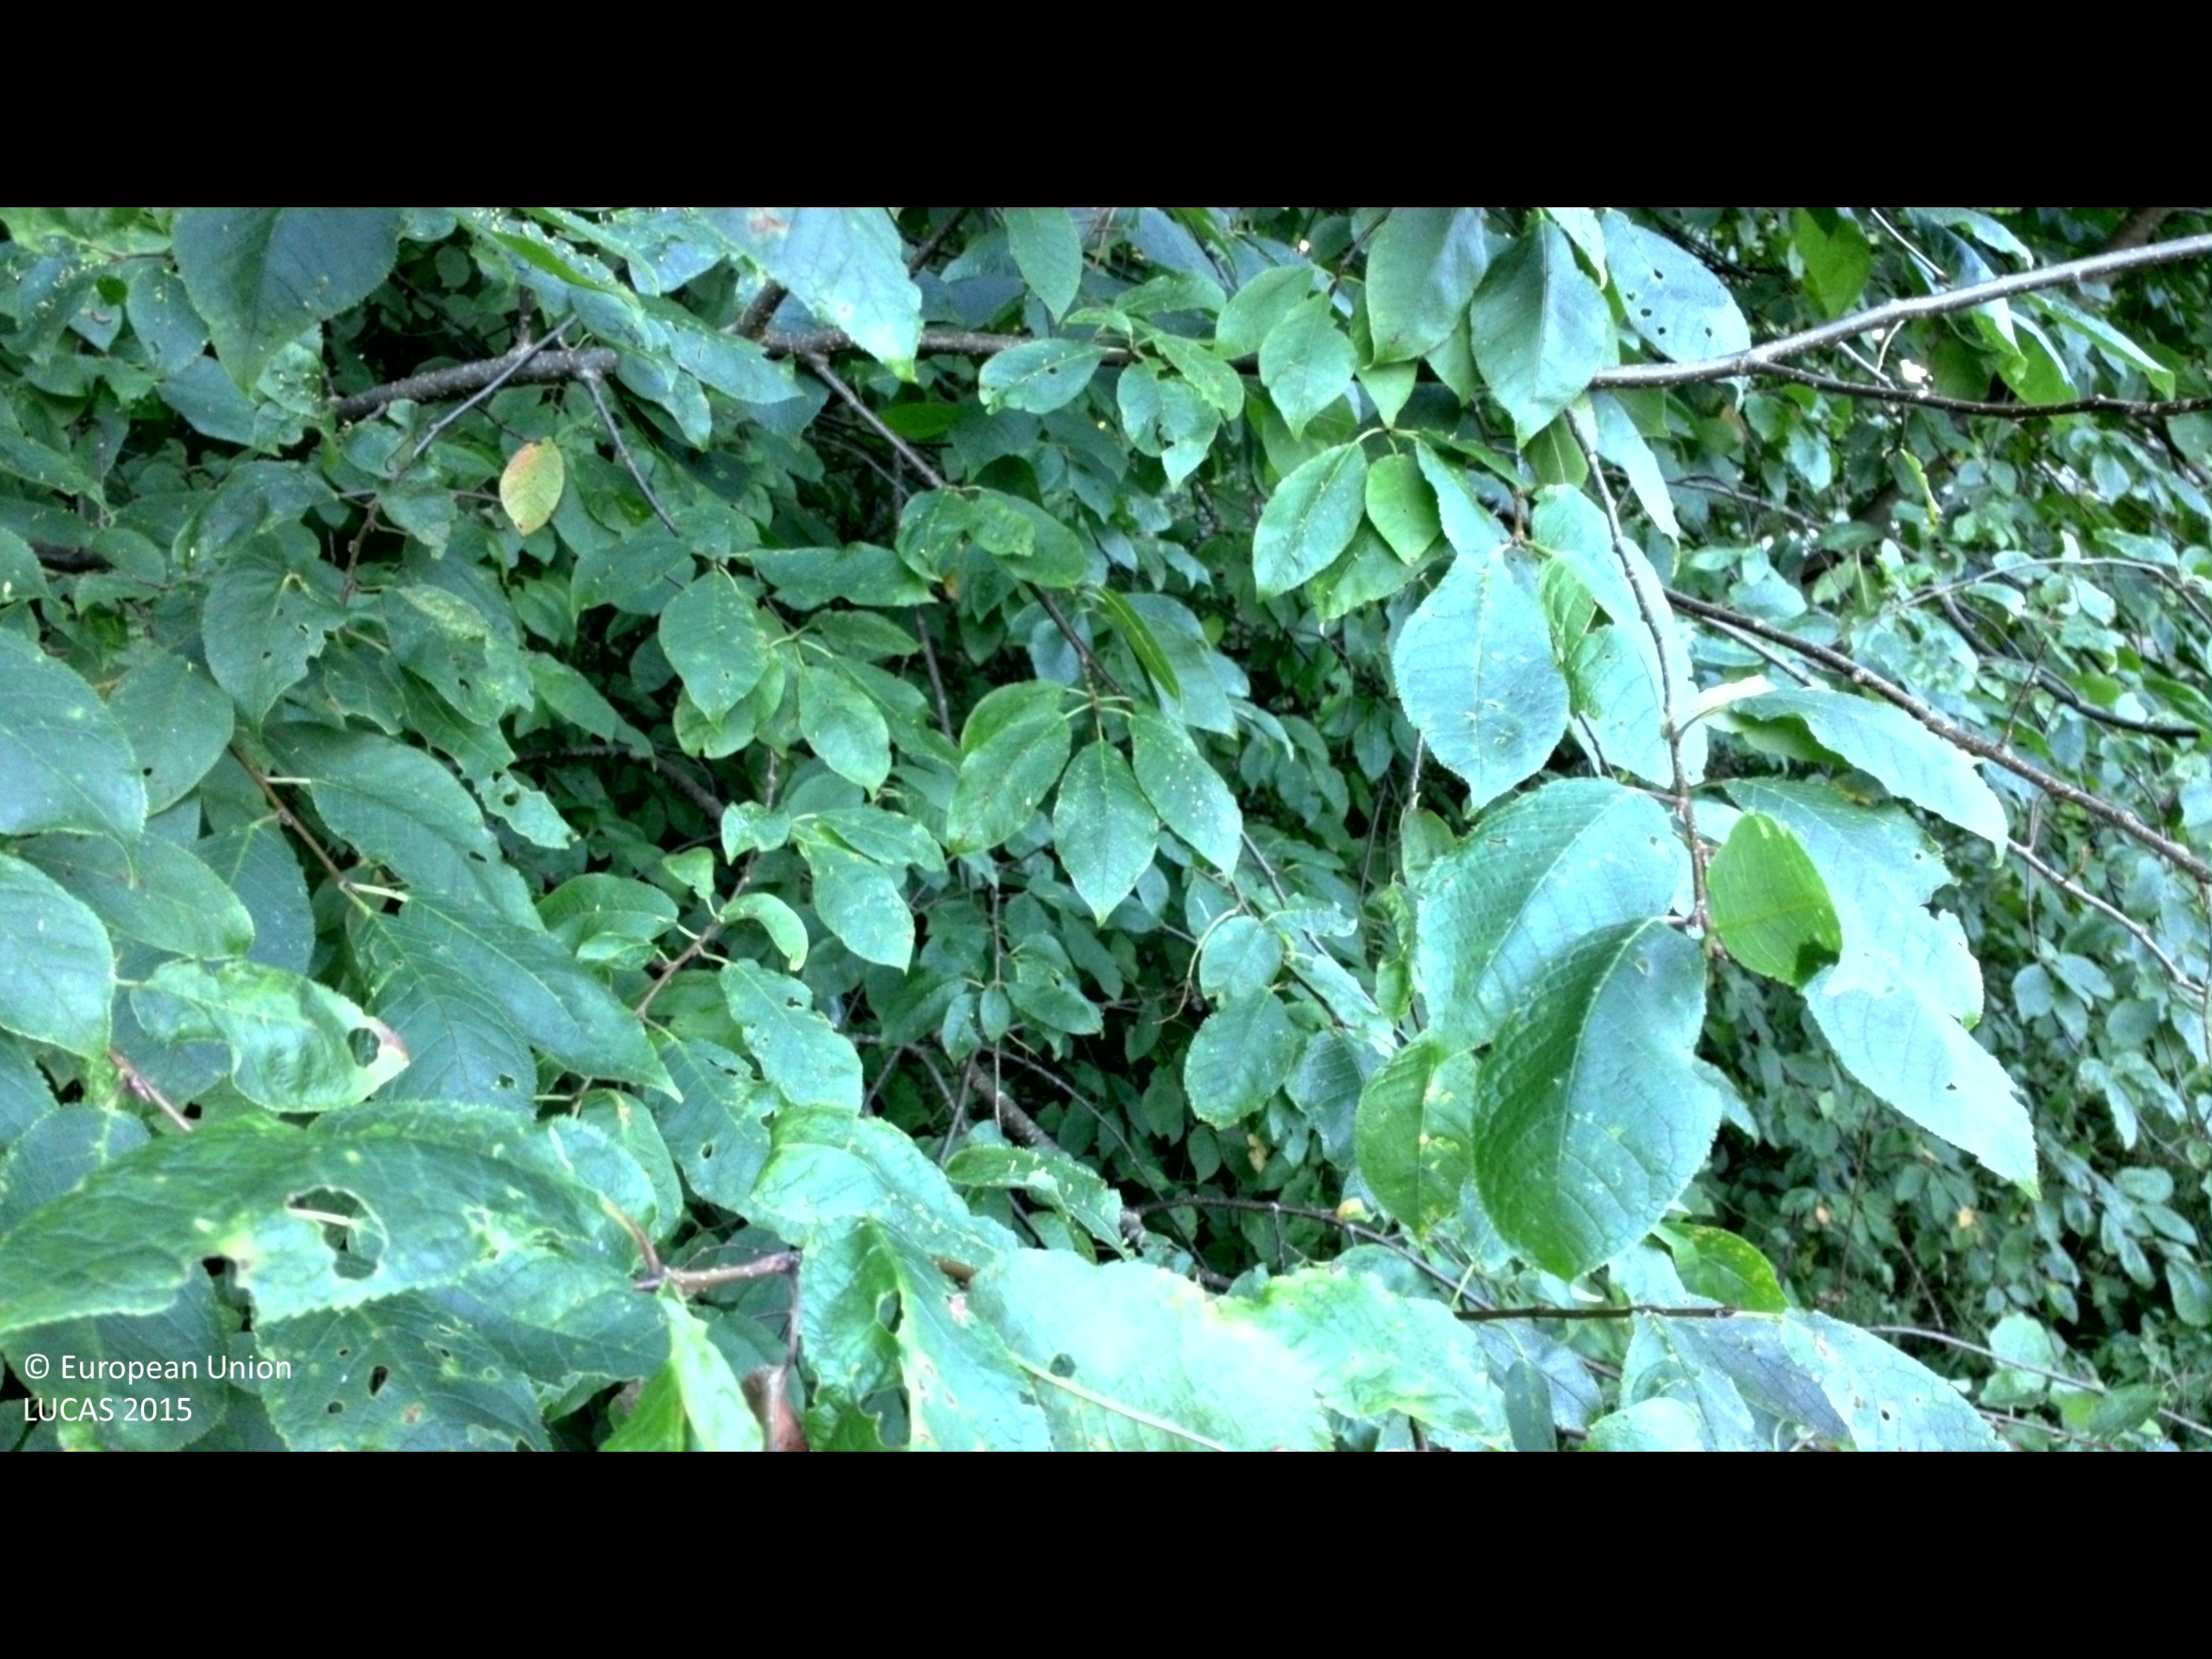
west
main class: Woodland
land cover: Broadleaved woodland
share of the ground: 50 - 75 %
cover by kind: broadleaved forest trees 60 %, shrubs 40 %
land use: Semi-natural and natural areas not in use
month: August
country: SE
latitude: 57.0106
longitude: 13.2404
